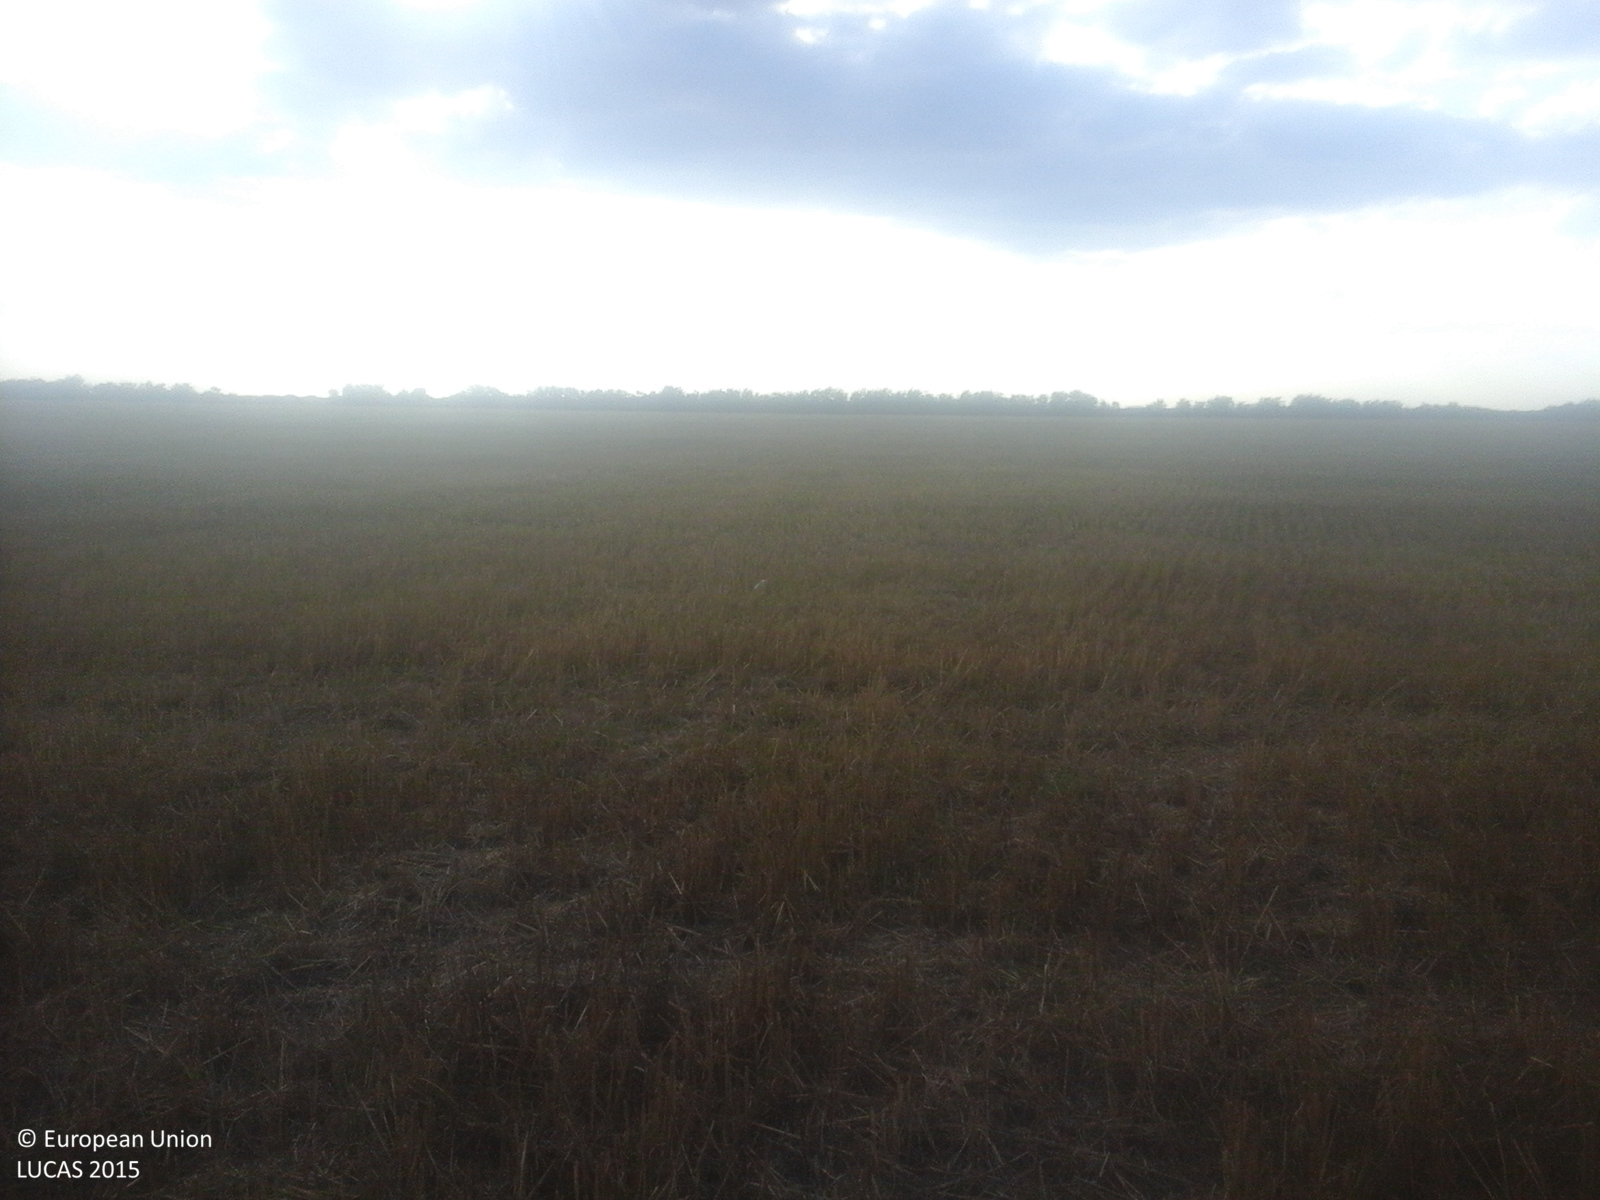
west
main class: Cropland
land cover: Common wheat
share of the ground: > 75 %
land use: Agriculture (excluding fallow land and kitchen gardens)
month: September
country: RO
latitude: 47.6730
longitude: 22.8090
